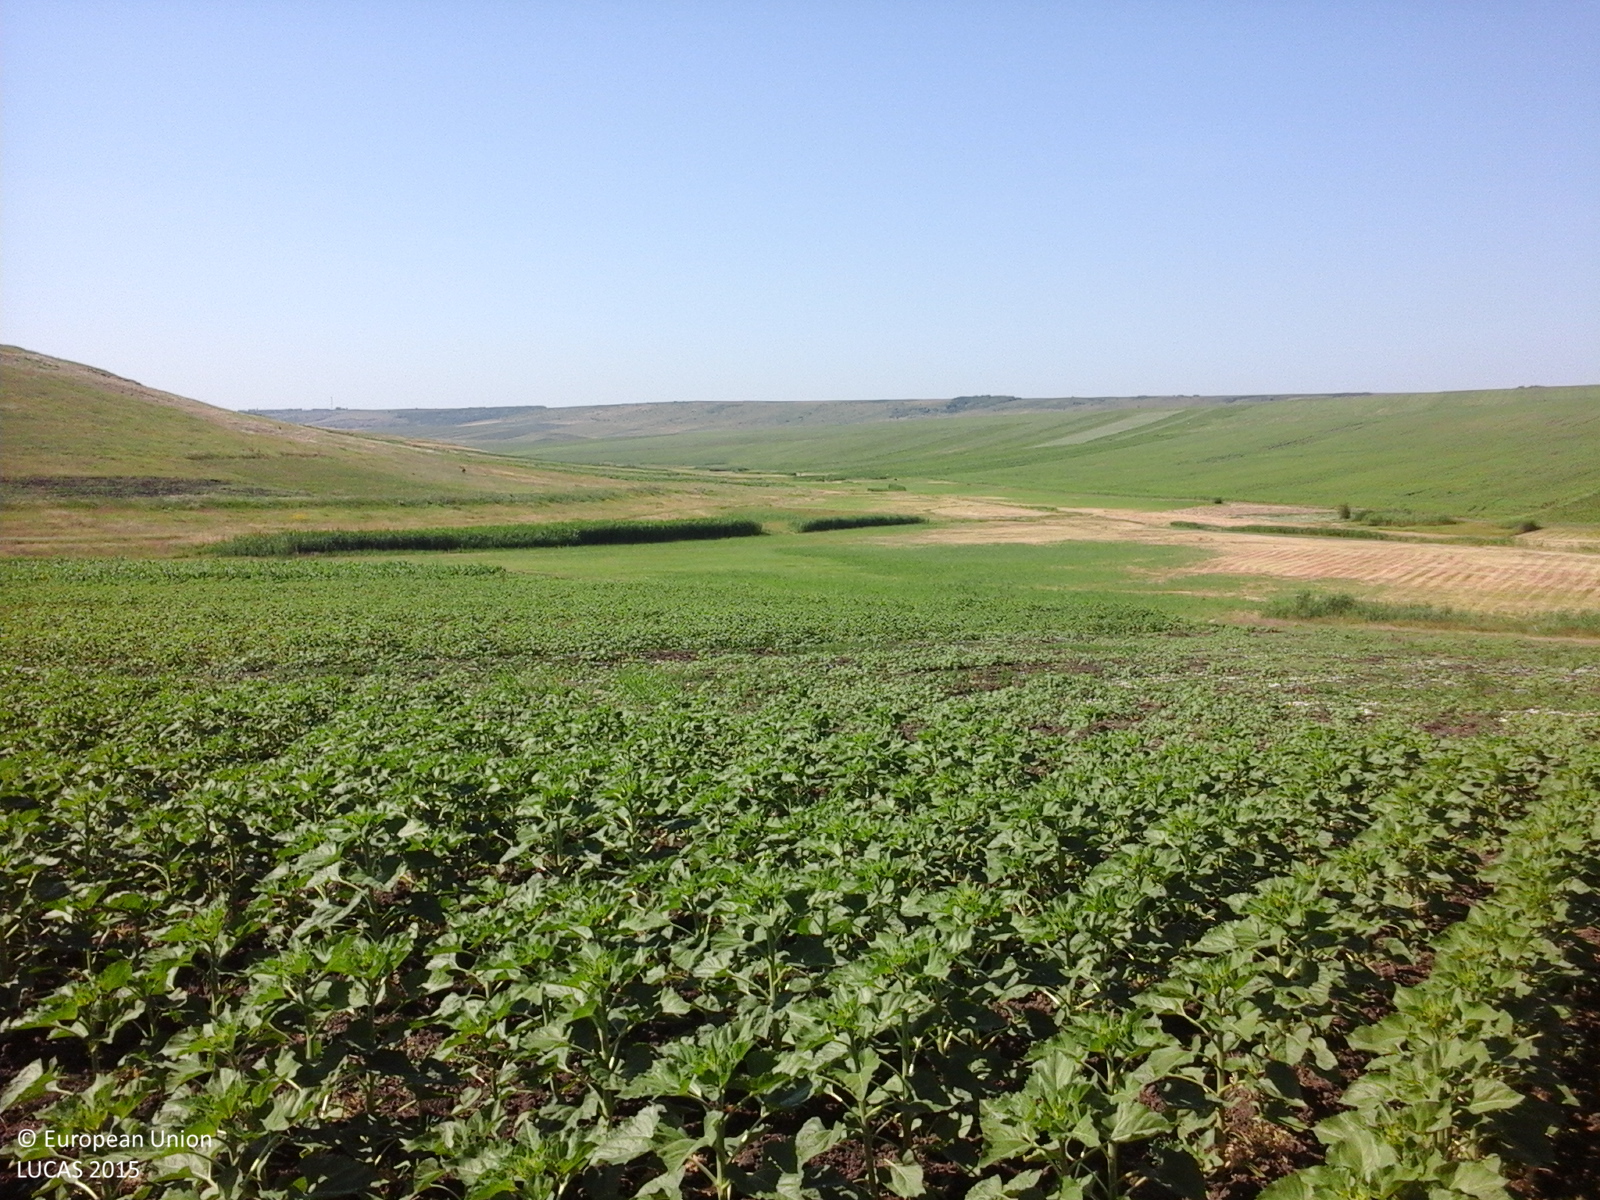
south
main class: Cropland
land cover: Sunflower
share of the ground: 50 - 75 %
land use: Agriculture (excluding fallow land and kitchen gardens)
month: June
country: RO
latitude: 47.3713
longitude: 27.0958
